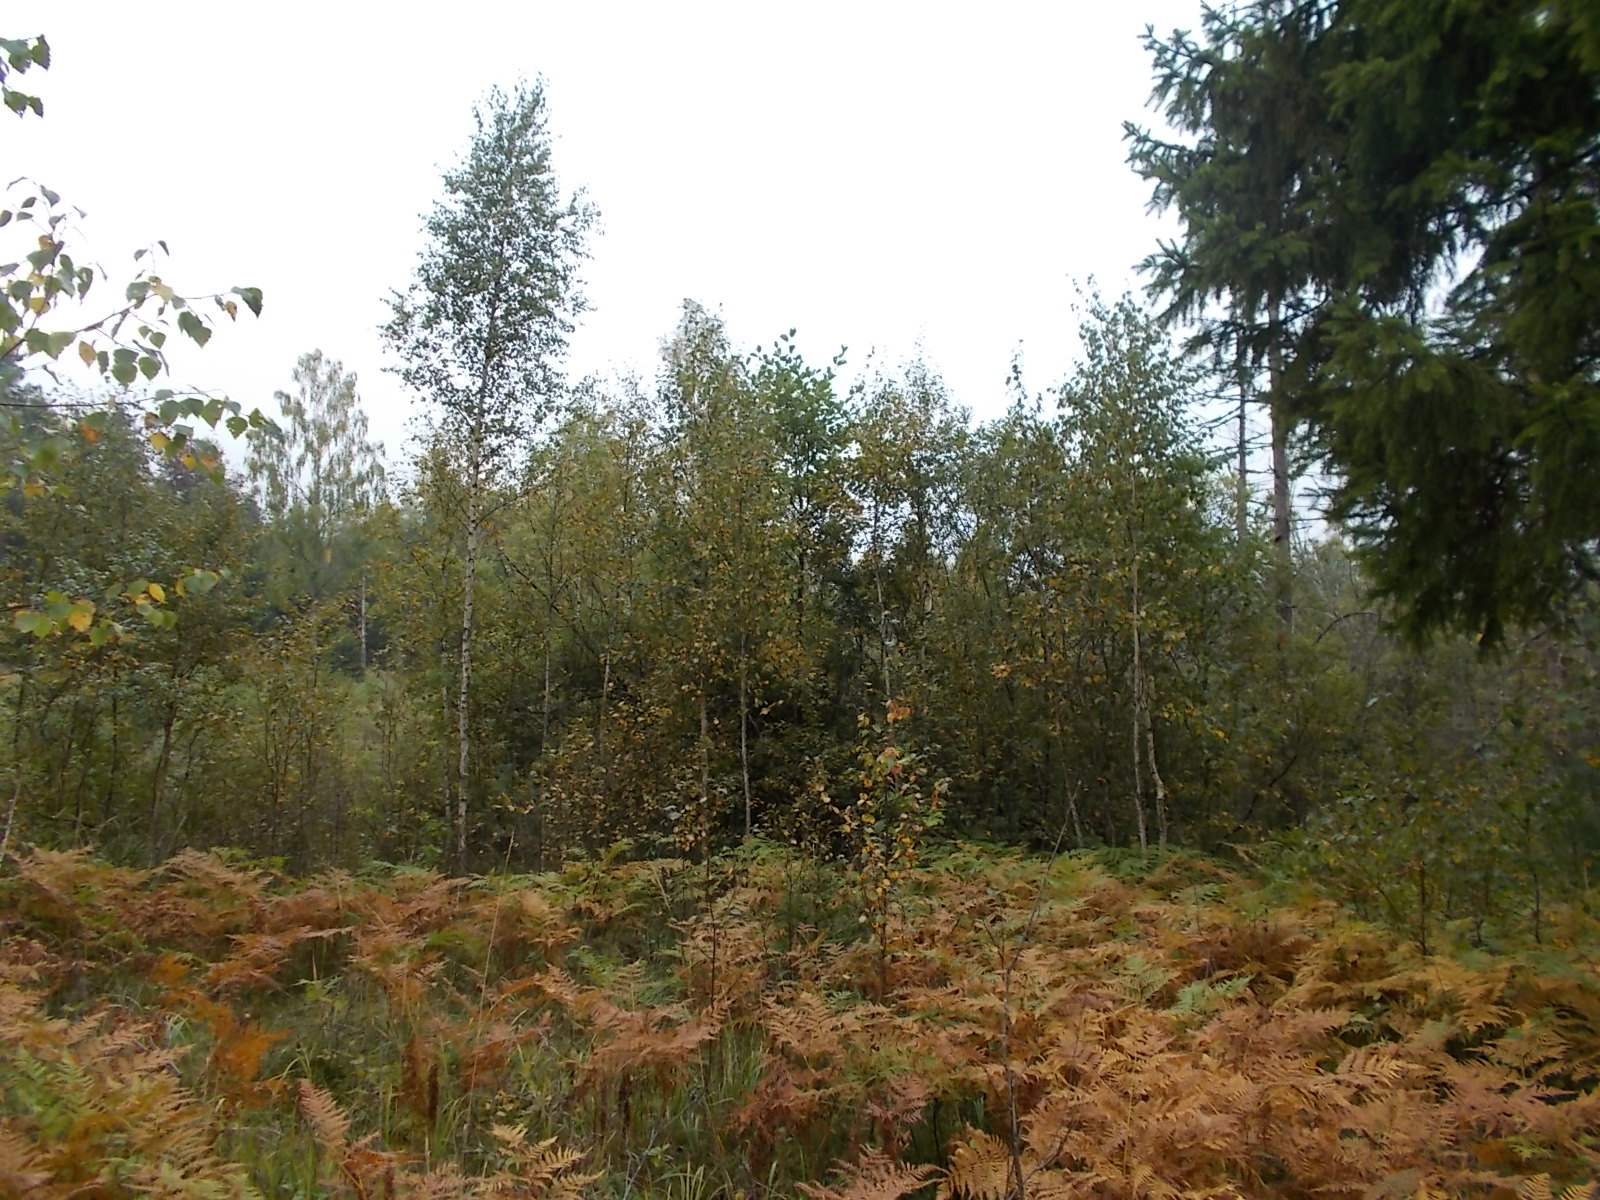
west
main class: Woodland
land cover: Other mixed woodland
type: hemiboreal forest and nemoral coniferous forest and mixed broadleaved-coniferous forest
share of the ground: 50 - 75 %
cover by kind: coniferous forest trees 30 %, broadleaved forest trees 30 %, herbaceous plants 30 %, shrubs 10 %
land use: Forestry
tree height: > 5 m
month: September
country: LV
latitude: 57.1602
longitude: 22.1013
